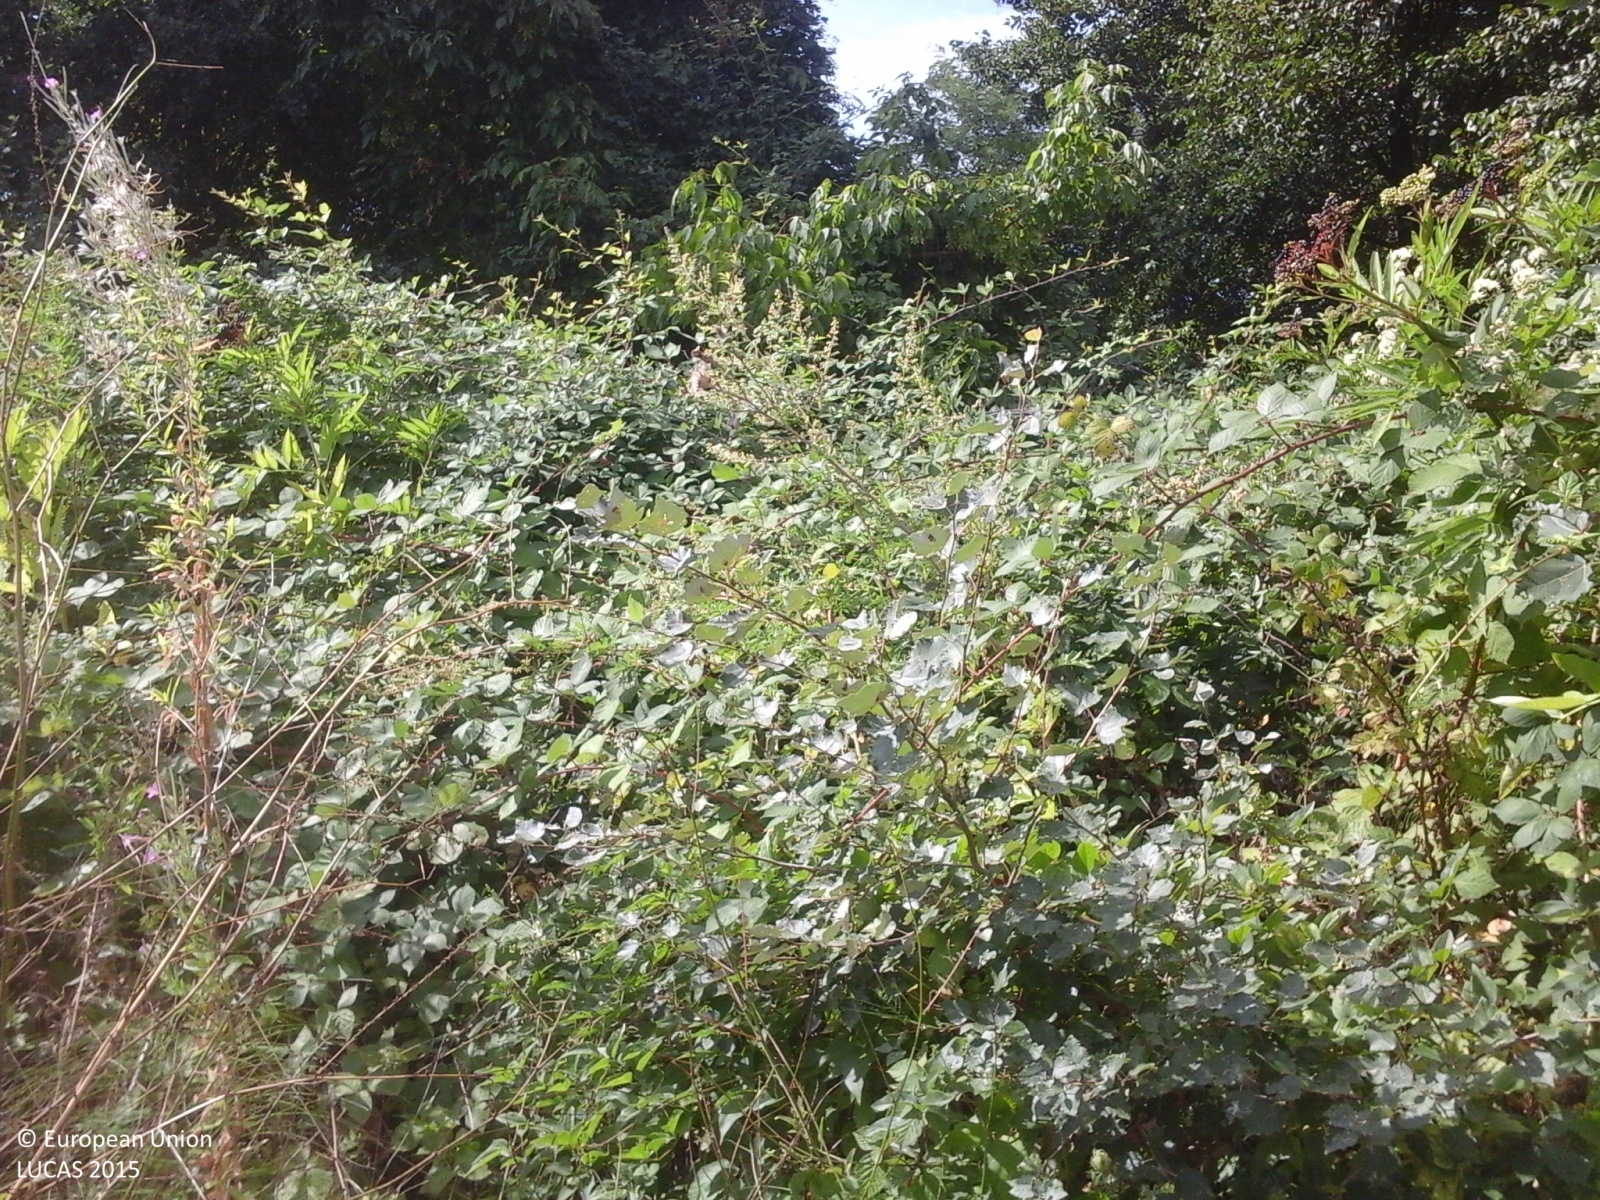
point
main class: Woodland
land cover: Broadleaved woodland
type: thermophilous deciduous forest
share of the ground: > 75 %
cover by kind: broadleaved forest trees 100 %
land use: Abandoned areas
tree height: > 5 m
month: August
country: IT
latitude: 43.9136
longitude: 10.9067
